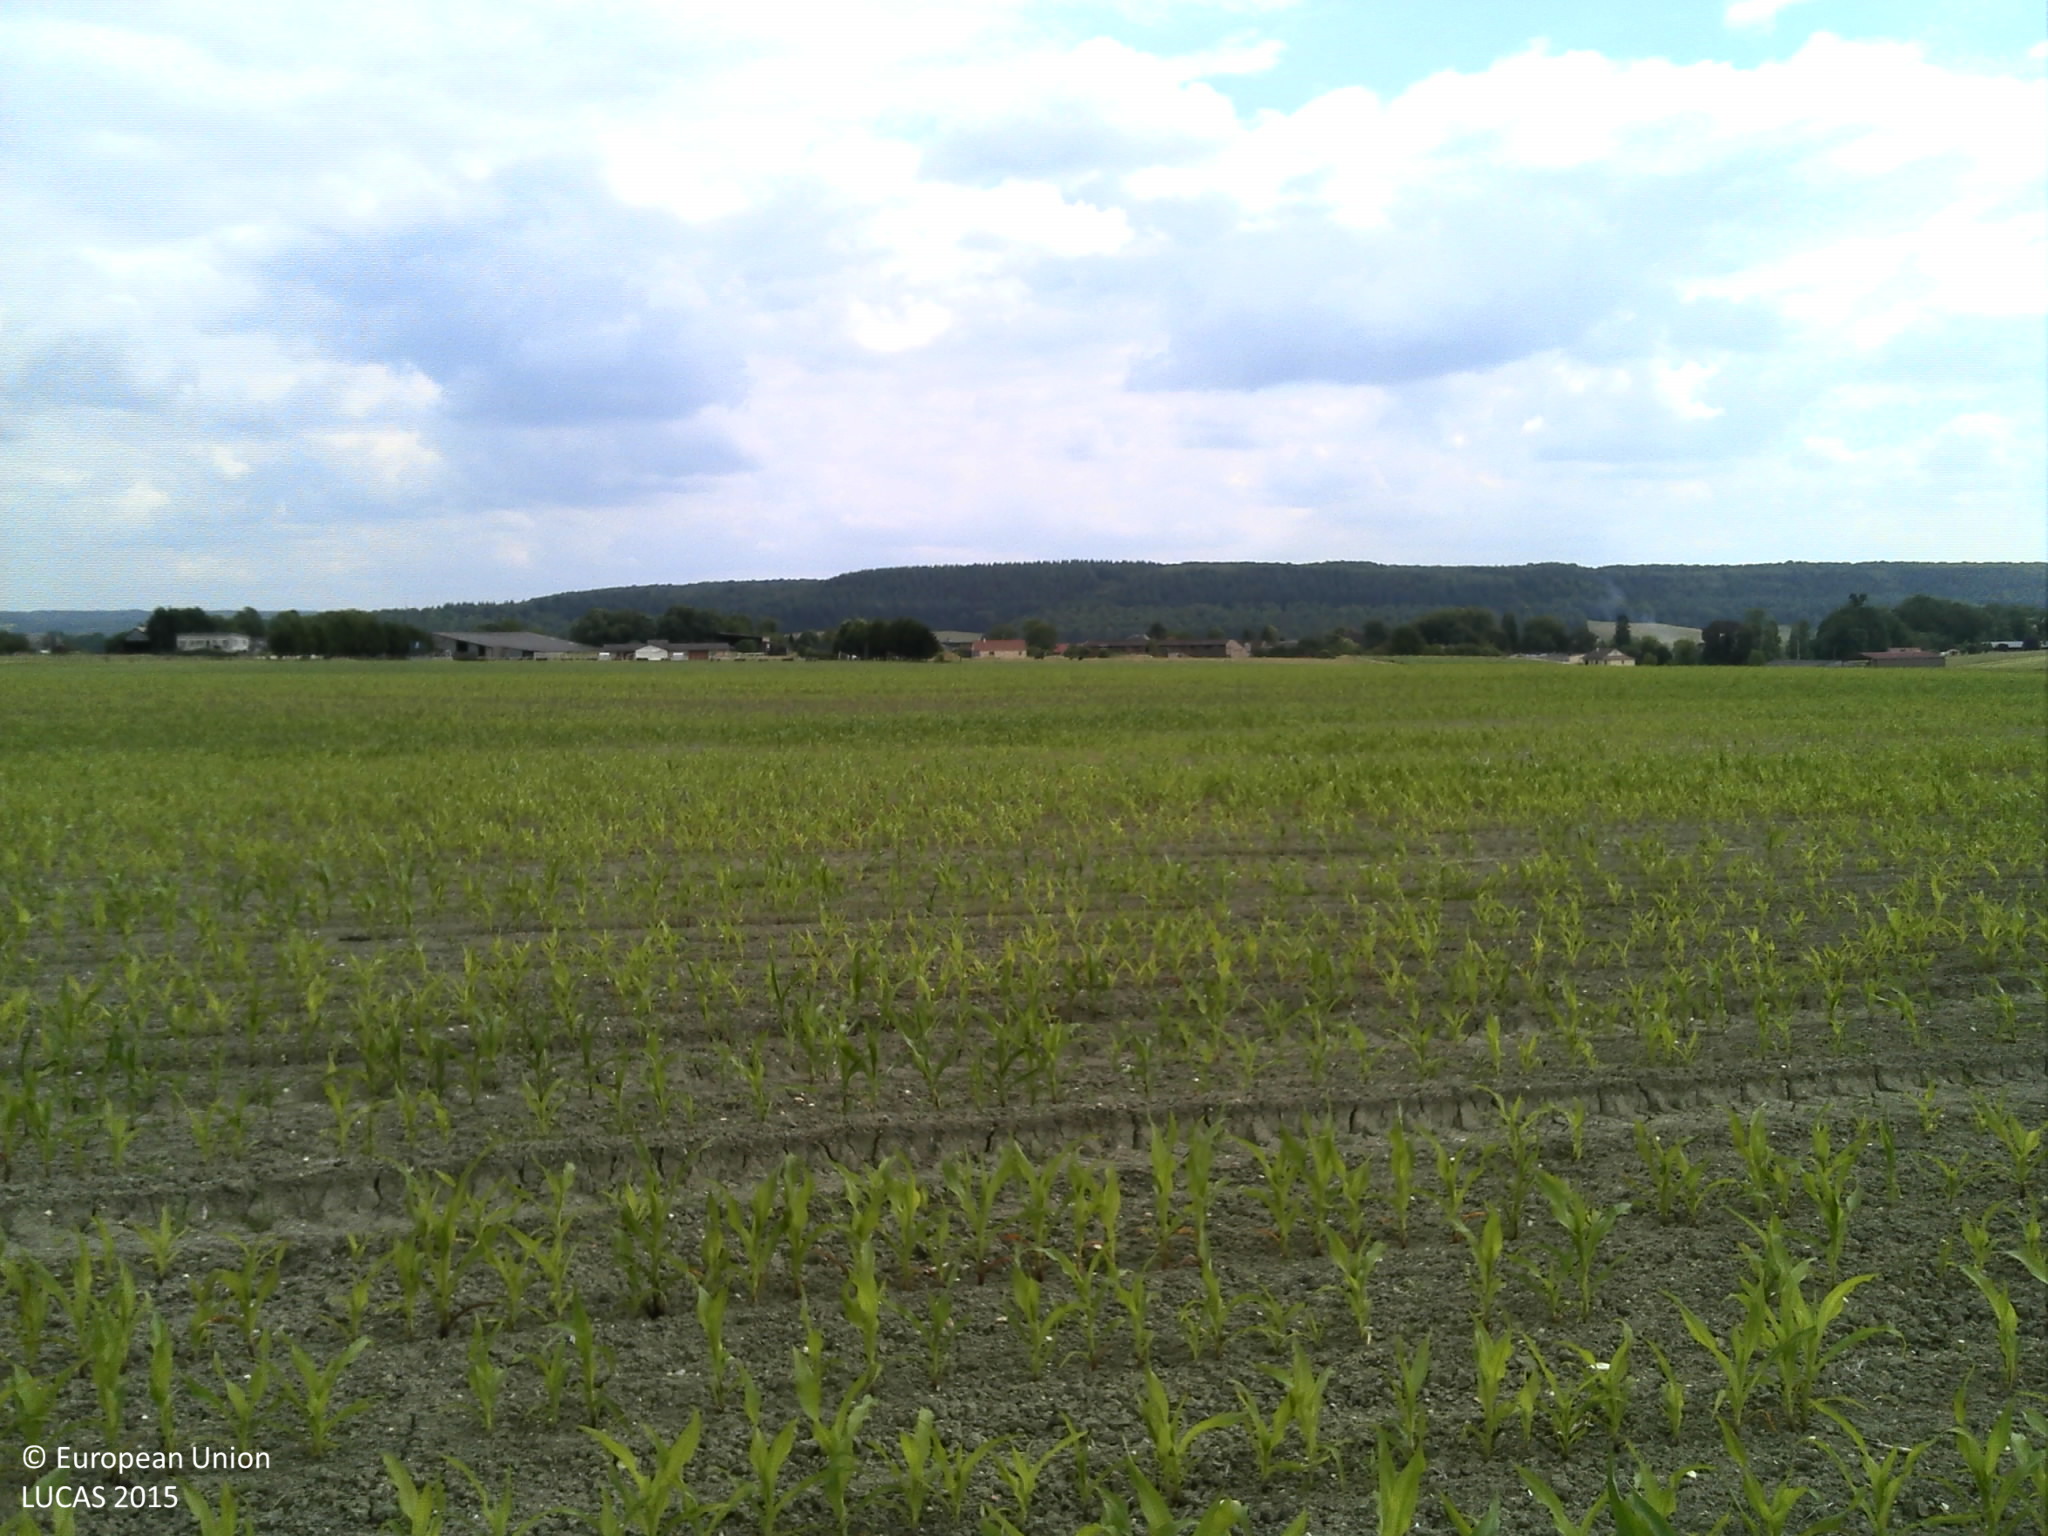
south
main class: Cropland
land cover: Maize
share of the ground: 25 - 50 %
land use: Agriculture (excluding fallow land and kitchen gardens)
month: June
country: FR
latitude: 49.3477
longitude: 4.8629
